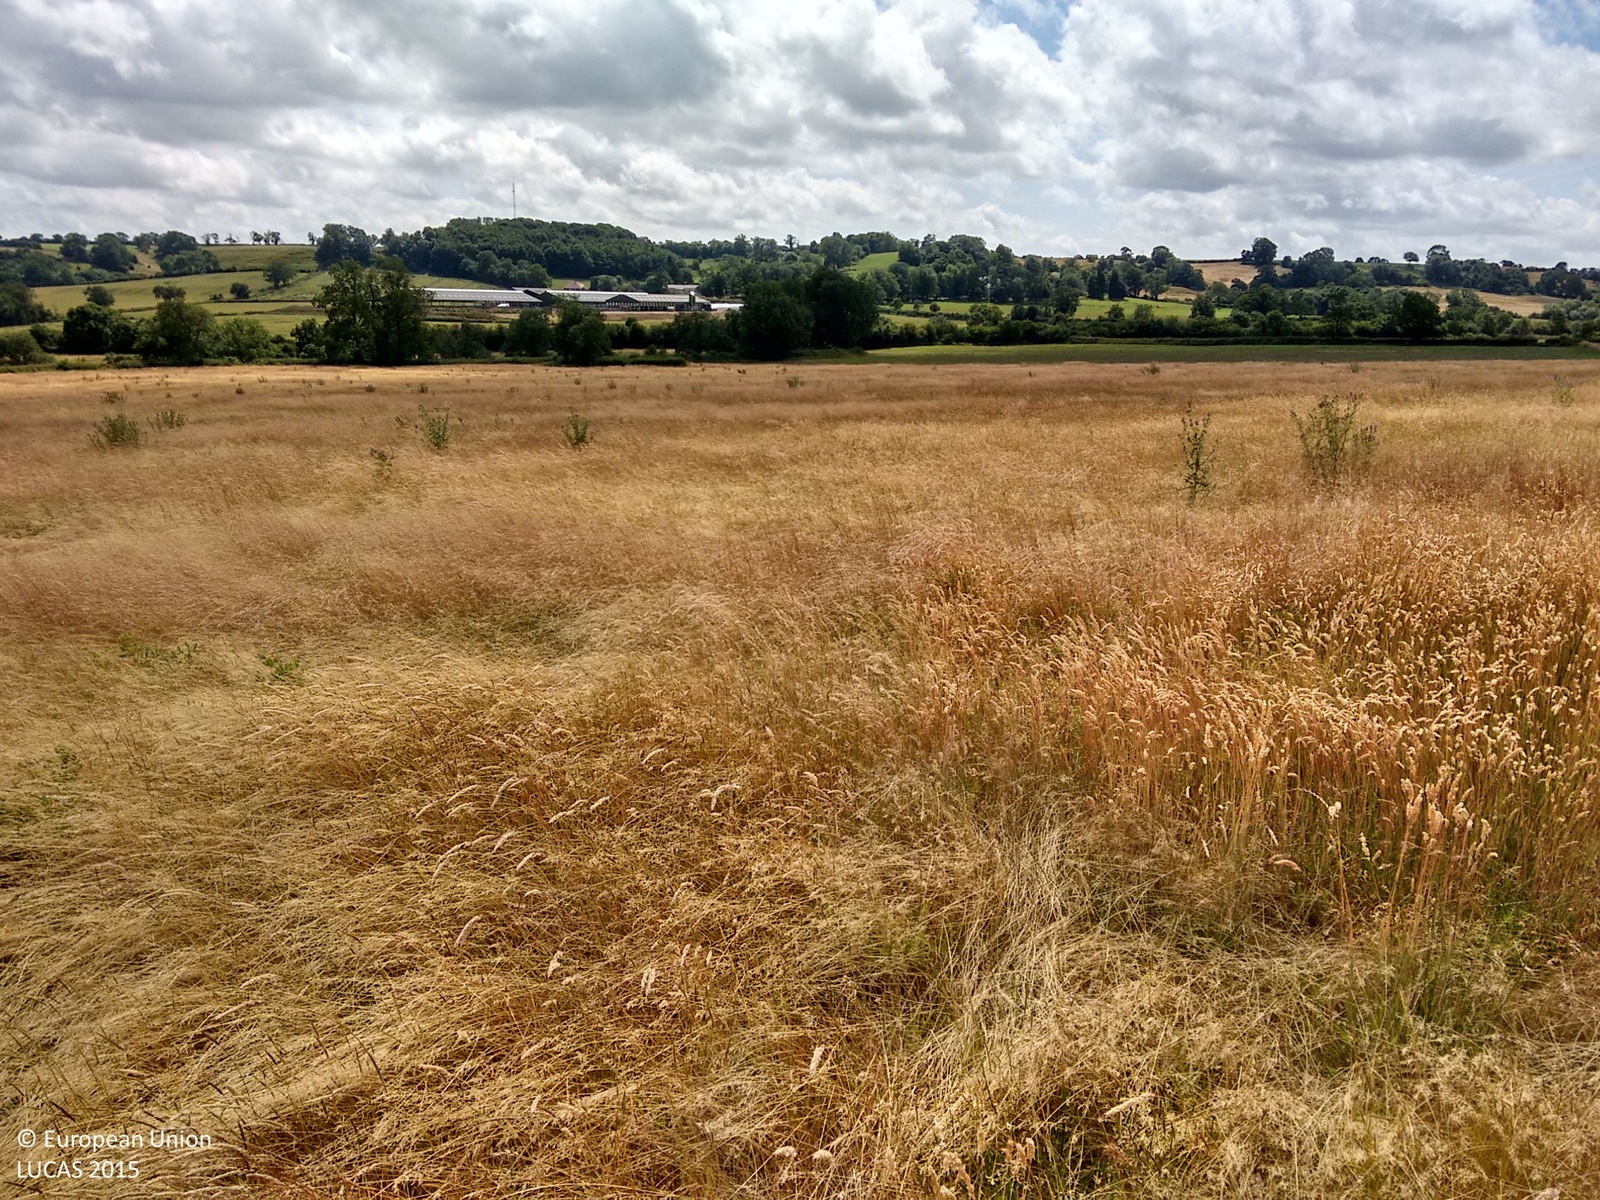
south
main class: Grassland
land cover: Grassland without tree/shrub cover
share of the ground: > 75 %
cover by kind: herbaceous plants 100 %
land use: Agriculture (excluding fallow land and kitchen gardens)
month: July
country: GB
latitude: 52.6508
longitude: -0.9373
